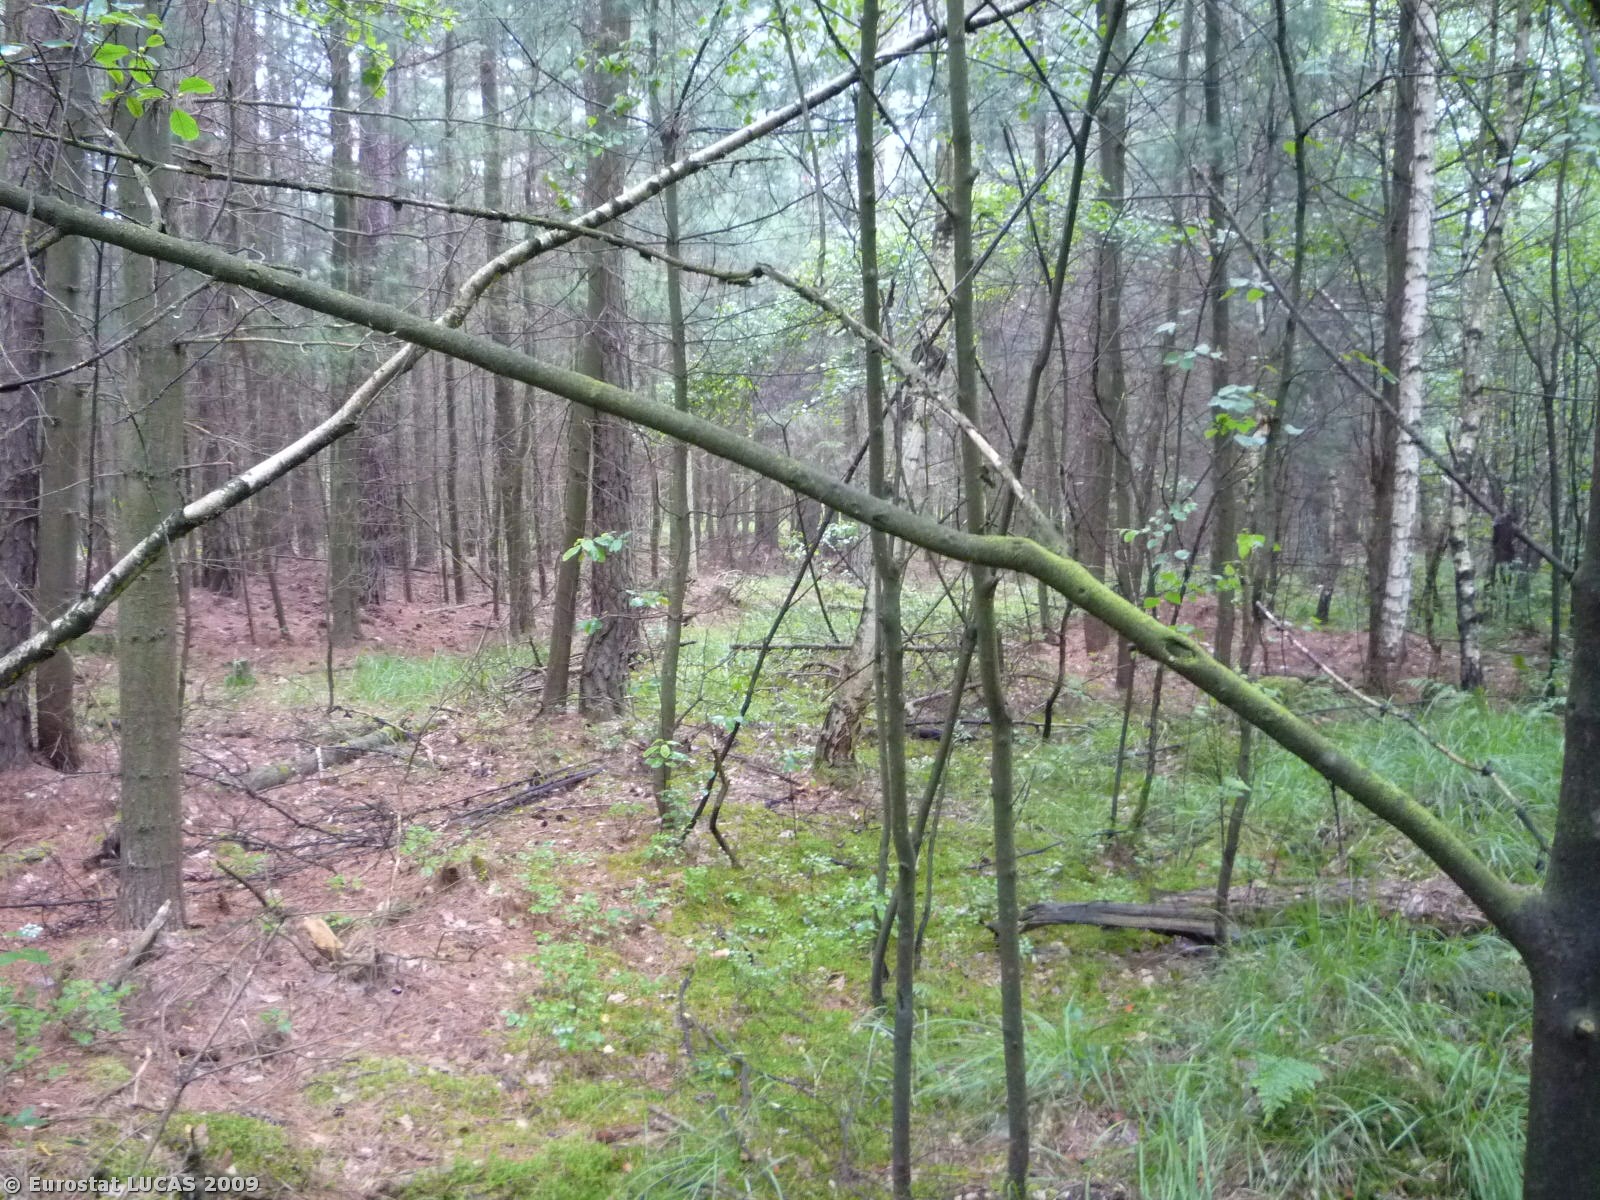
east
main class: Woodland
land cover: Mixed woodland
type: hemiboreal forest and nemoral coniferous forest and mixed broadleaved-coniferous forest
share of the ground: > 75 %
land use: Forestry
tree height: > 5 m
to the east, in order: Mixed woodland; Tracks; Coniferous woodland; Ditches and canals; Broadleaved woodland; Coniferous woodland; Tracks; Mixed woodland
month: June
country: CZ
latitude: 50.0725
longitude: 15.4390
